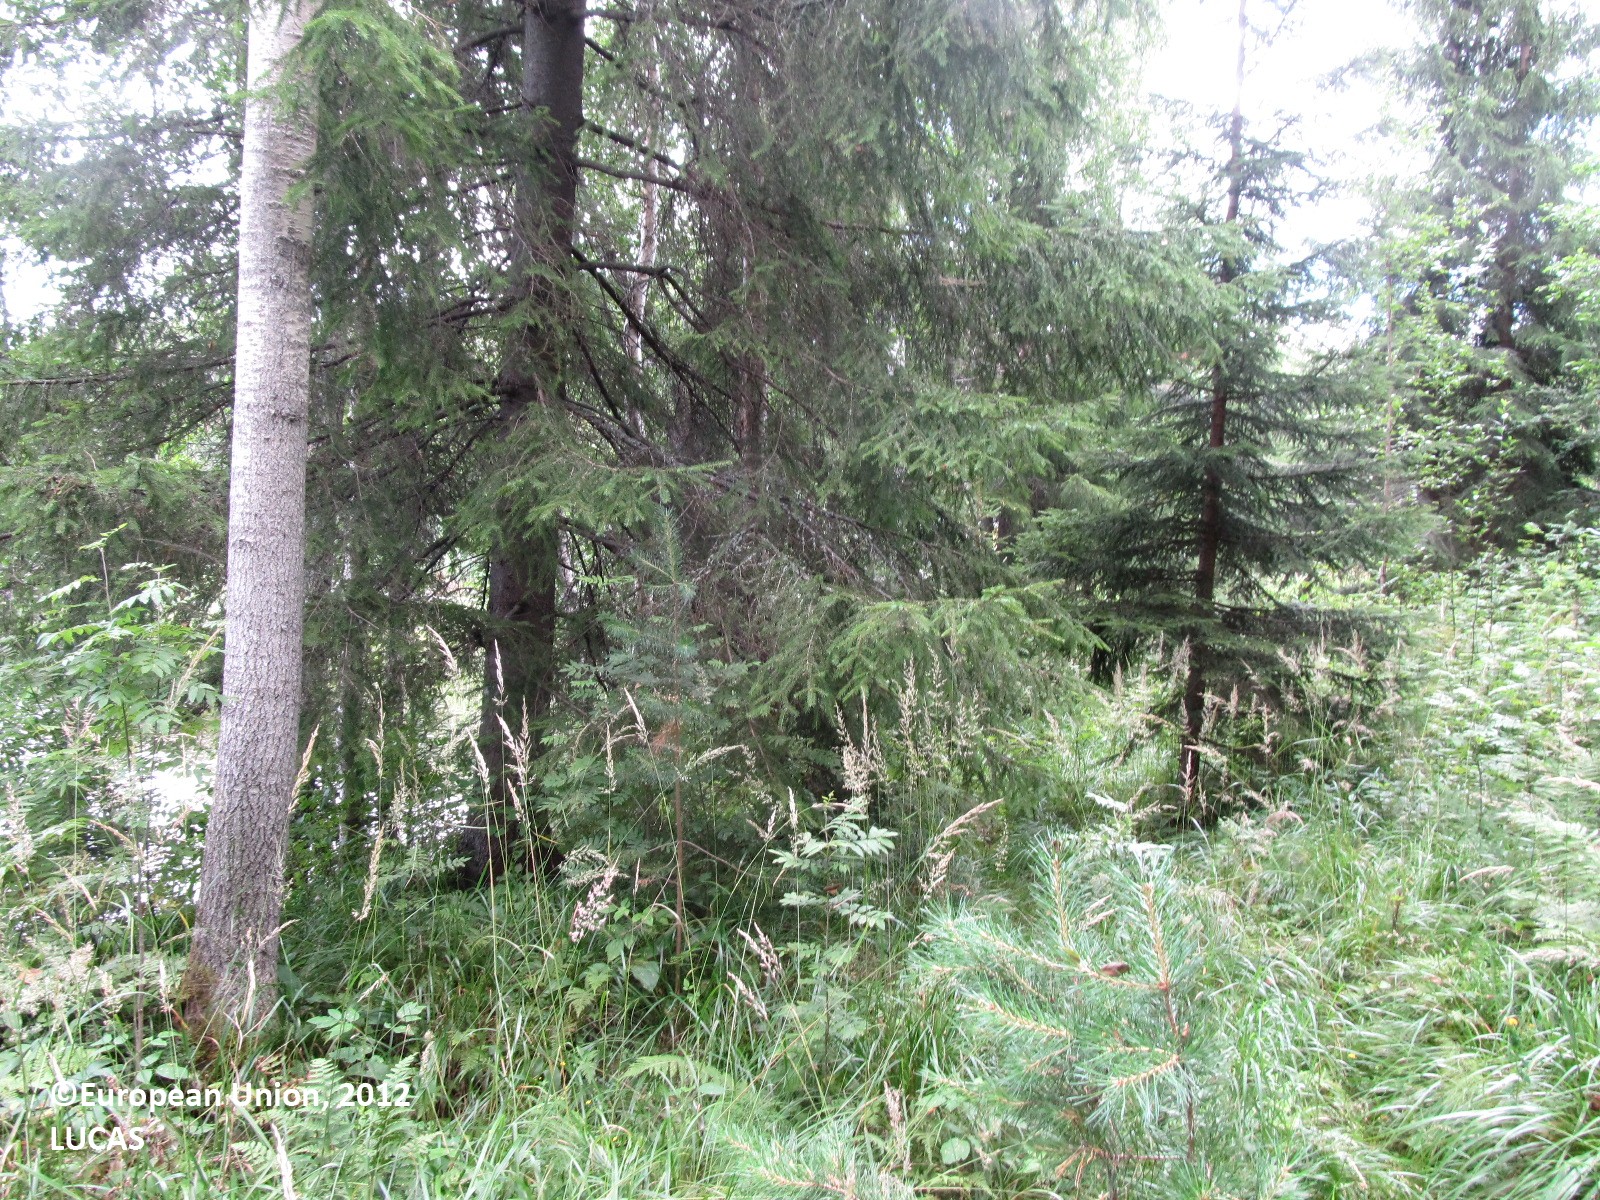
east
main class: Woodland
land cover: Spruce dominated mixed woodland
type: boreal forest
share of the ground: 50 - 75 %
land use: Forestry
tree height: > 5 m
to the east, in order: Spruce dominated mixed woodland; Inland water bodies; Pine dominated mixed woodland; Broadleaved woodland; Paved roads, cycling and walking lanes; Spruce dominated coniferous woodland
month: August
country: FI
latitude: 61.7922
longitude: 27.8422
